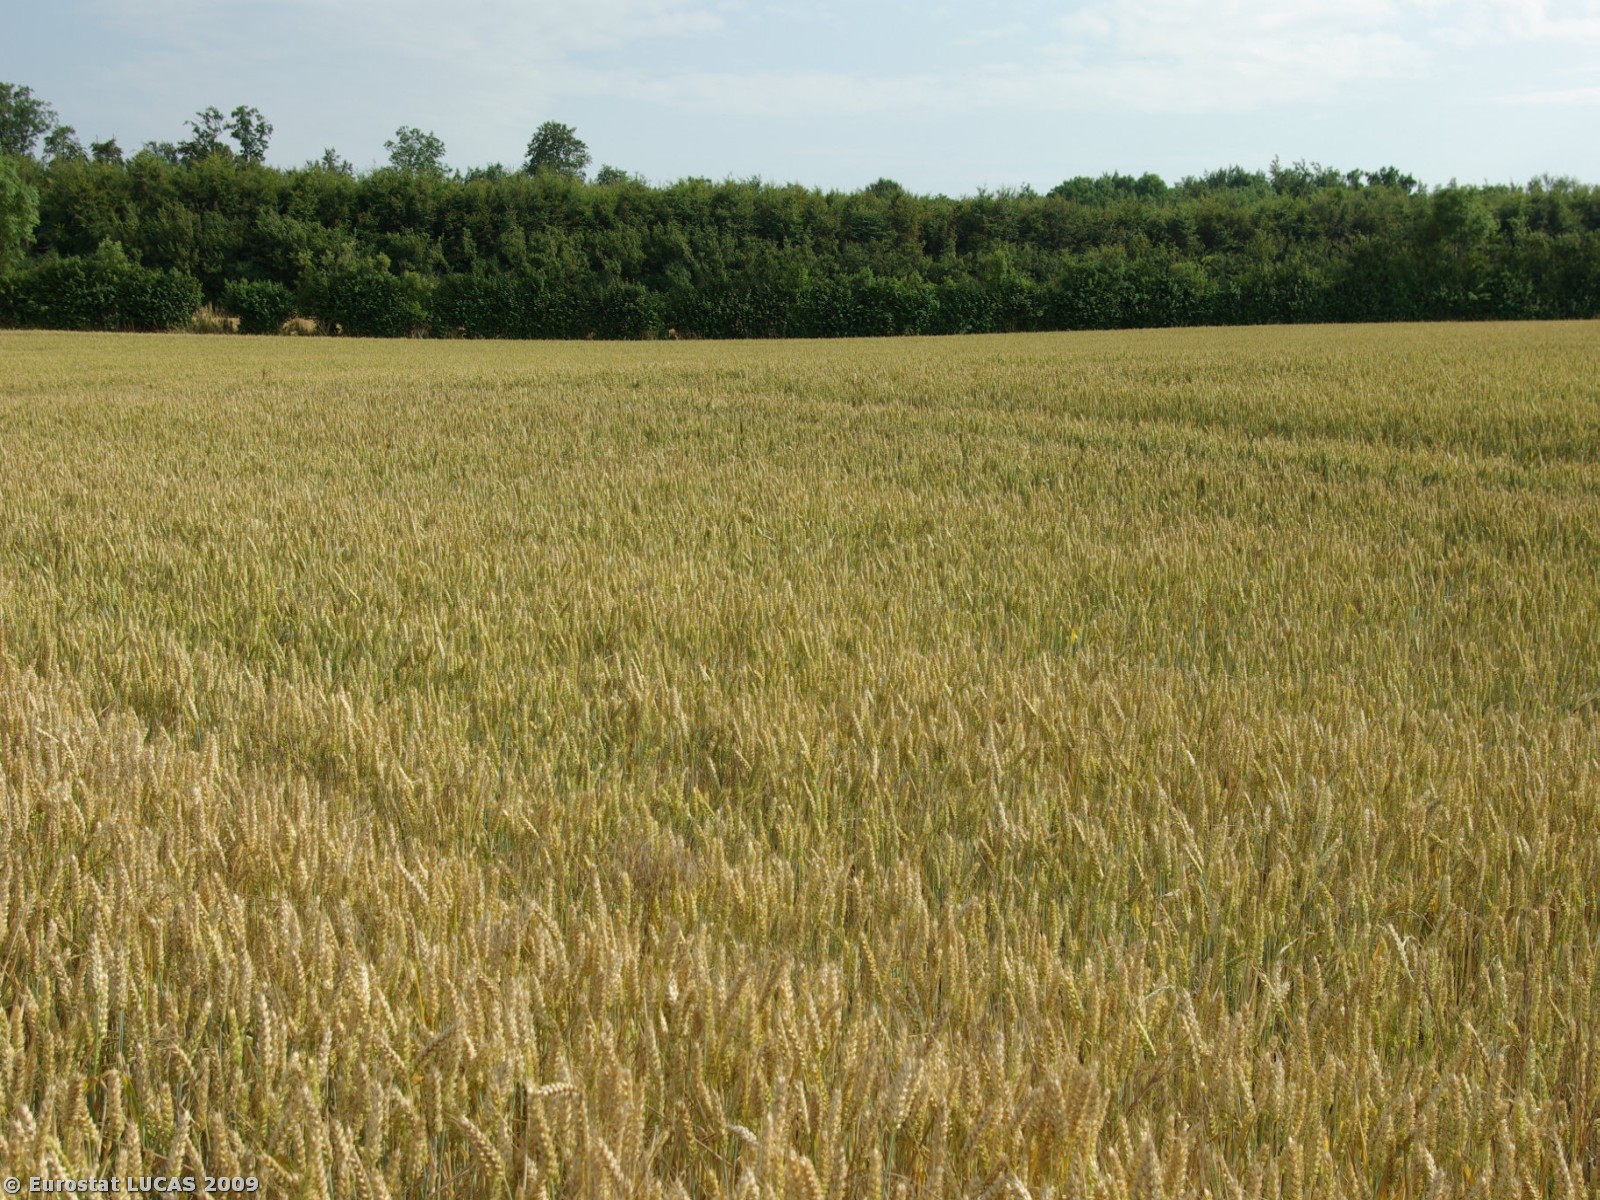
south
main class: Cropland
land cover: Common wheat
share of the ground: > 75 %
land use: Agriculture (excluding fallow land and kitchen gardens)
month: July
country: DK
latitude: 55.0373
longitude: 9.8593
